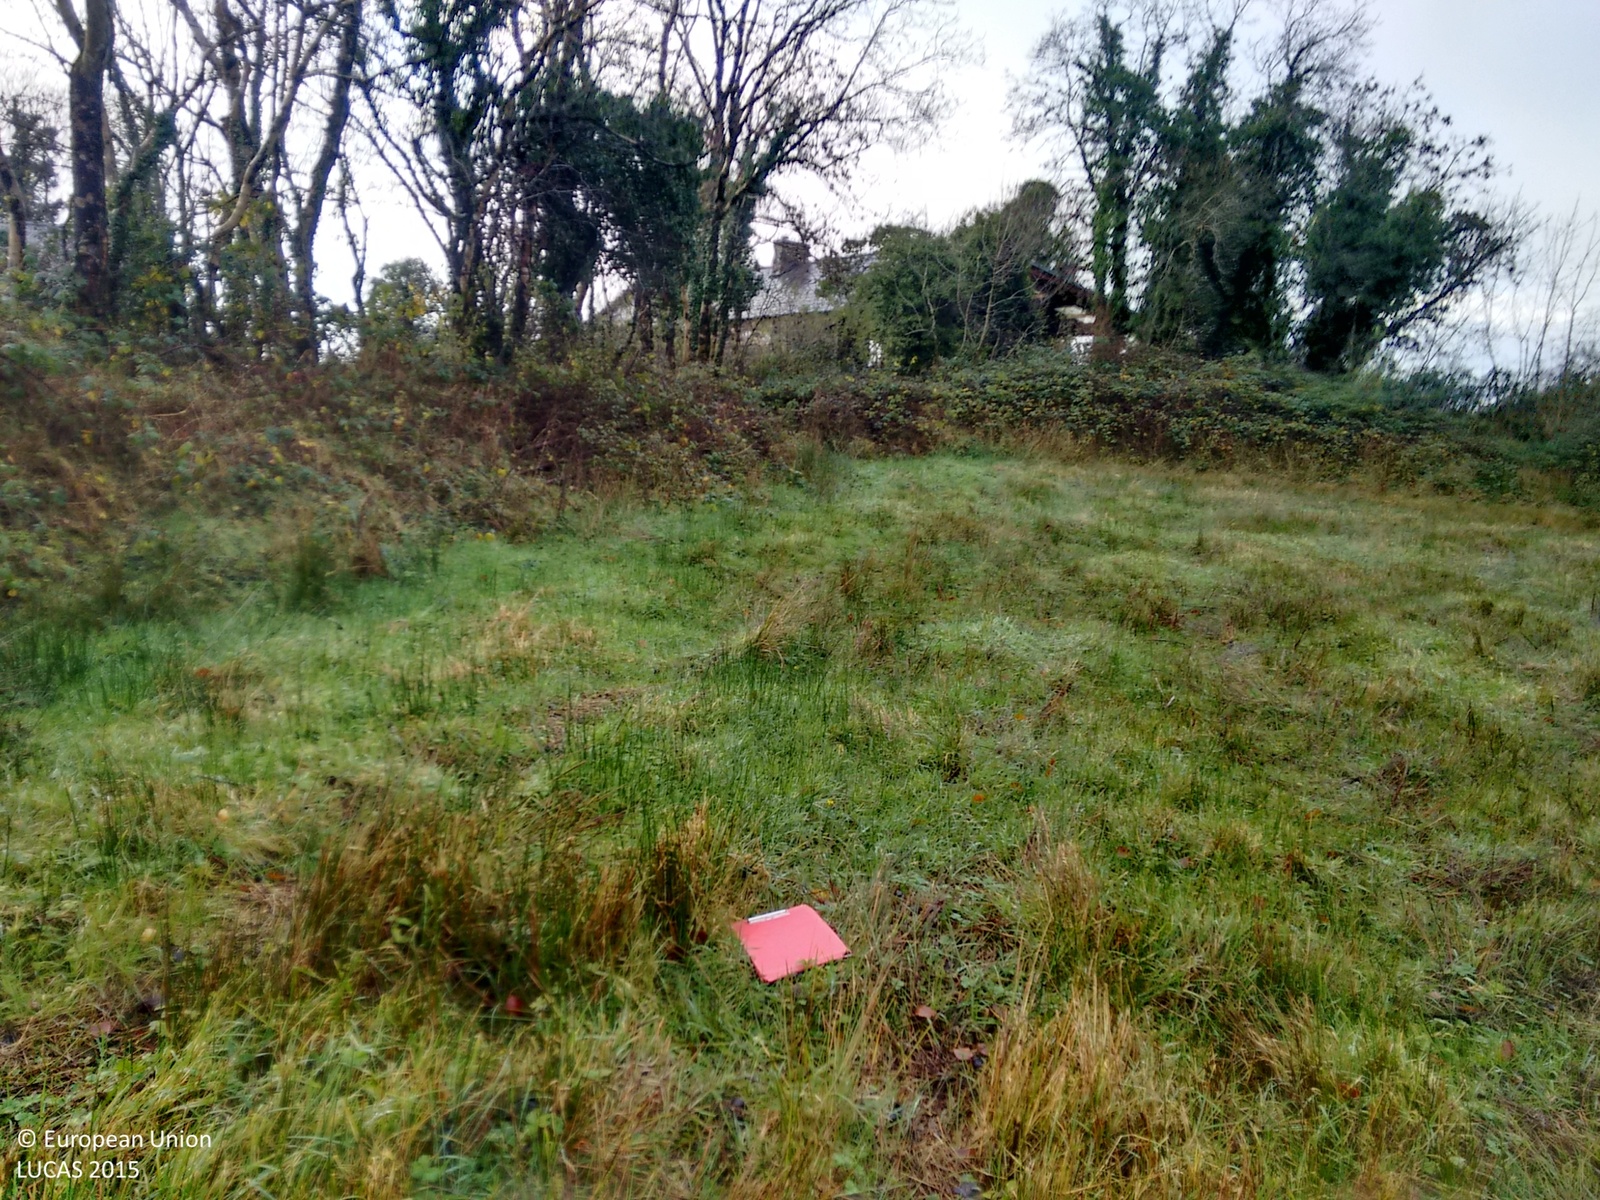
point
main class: Grassland
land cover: Grassland without tree/shrub cover
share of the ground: > 75 %
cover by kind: herbaceous plants 95 %, unconsolidated bare surface 5 %
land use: Agriculture (excluding fallow land and kitchen gardens)
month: November
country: IE
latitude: 53.9486
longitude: -8.0489
